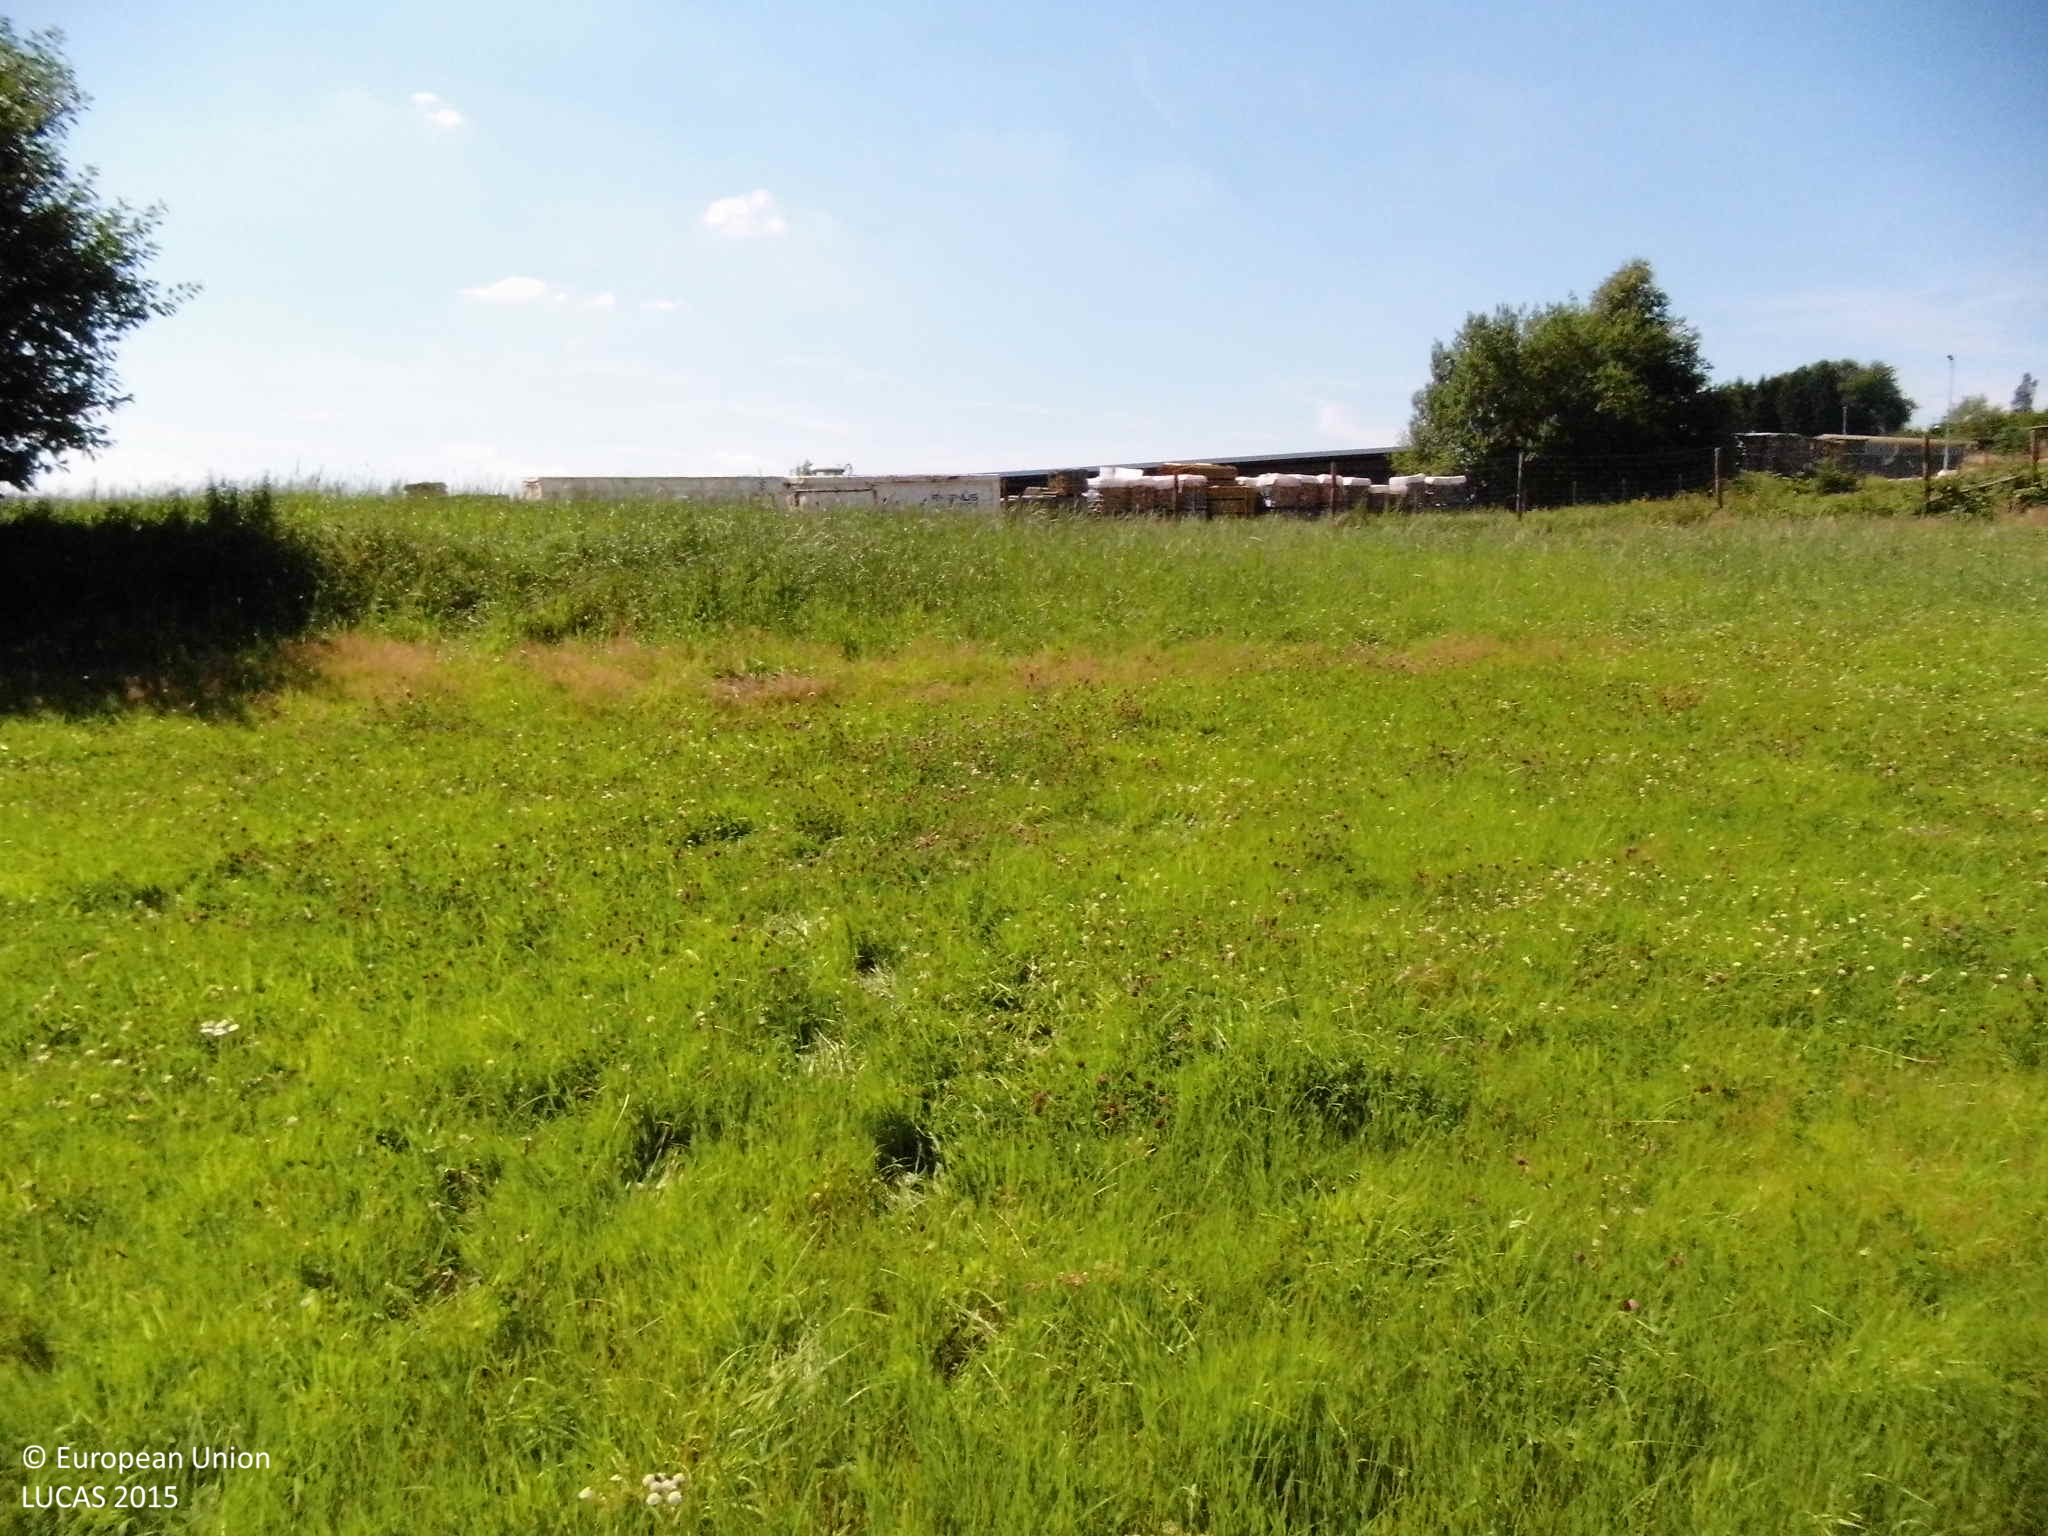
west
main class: Grassland
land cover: Grassland without tree/shrub cover
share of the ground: > 75 %
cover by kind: herbaceous plants 100 %
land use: Agriculture (excluding fallow land and kitchen gardens)
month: August
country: DE
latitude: 51.1921
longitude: 8.0114
